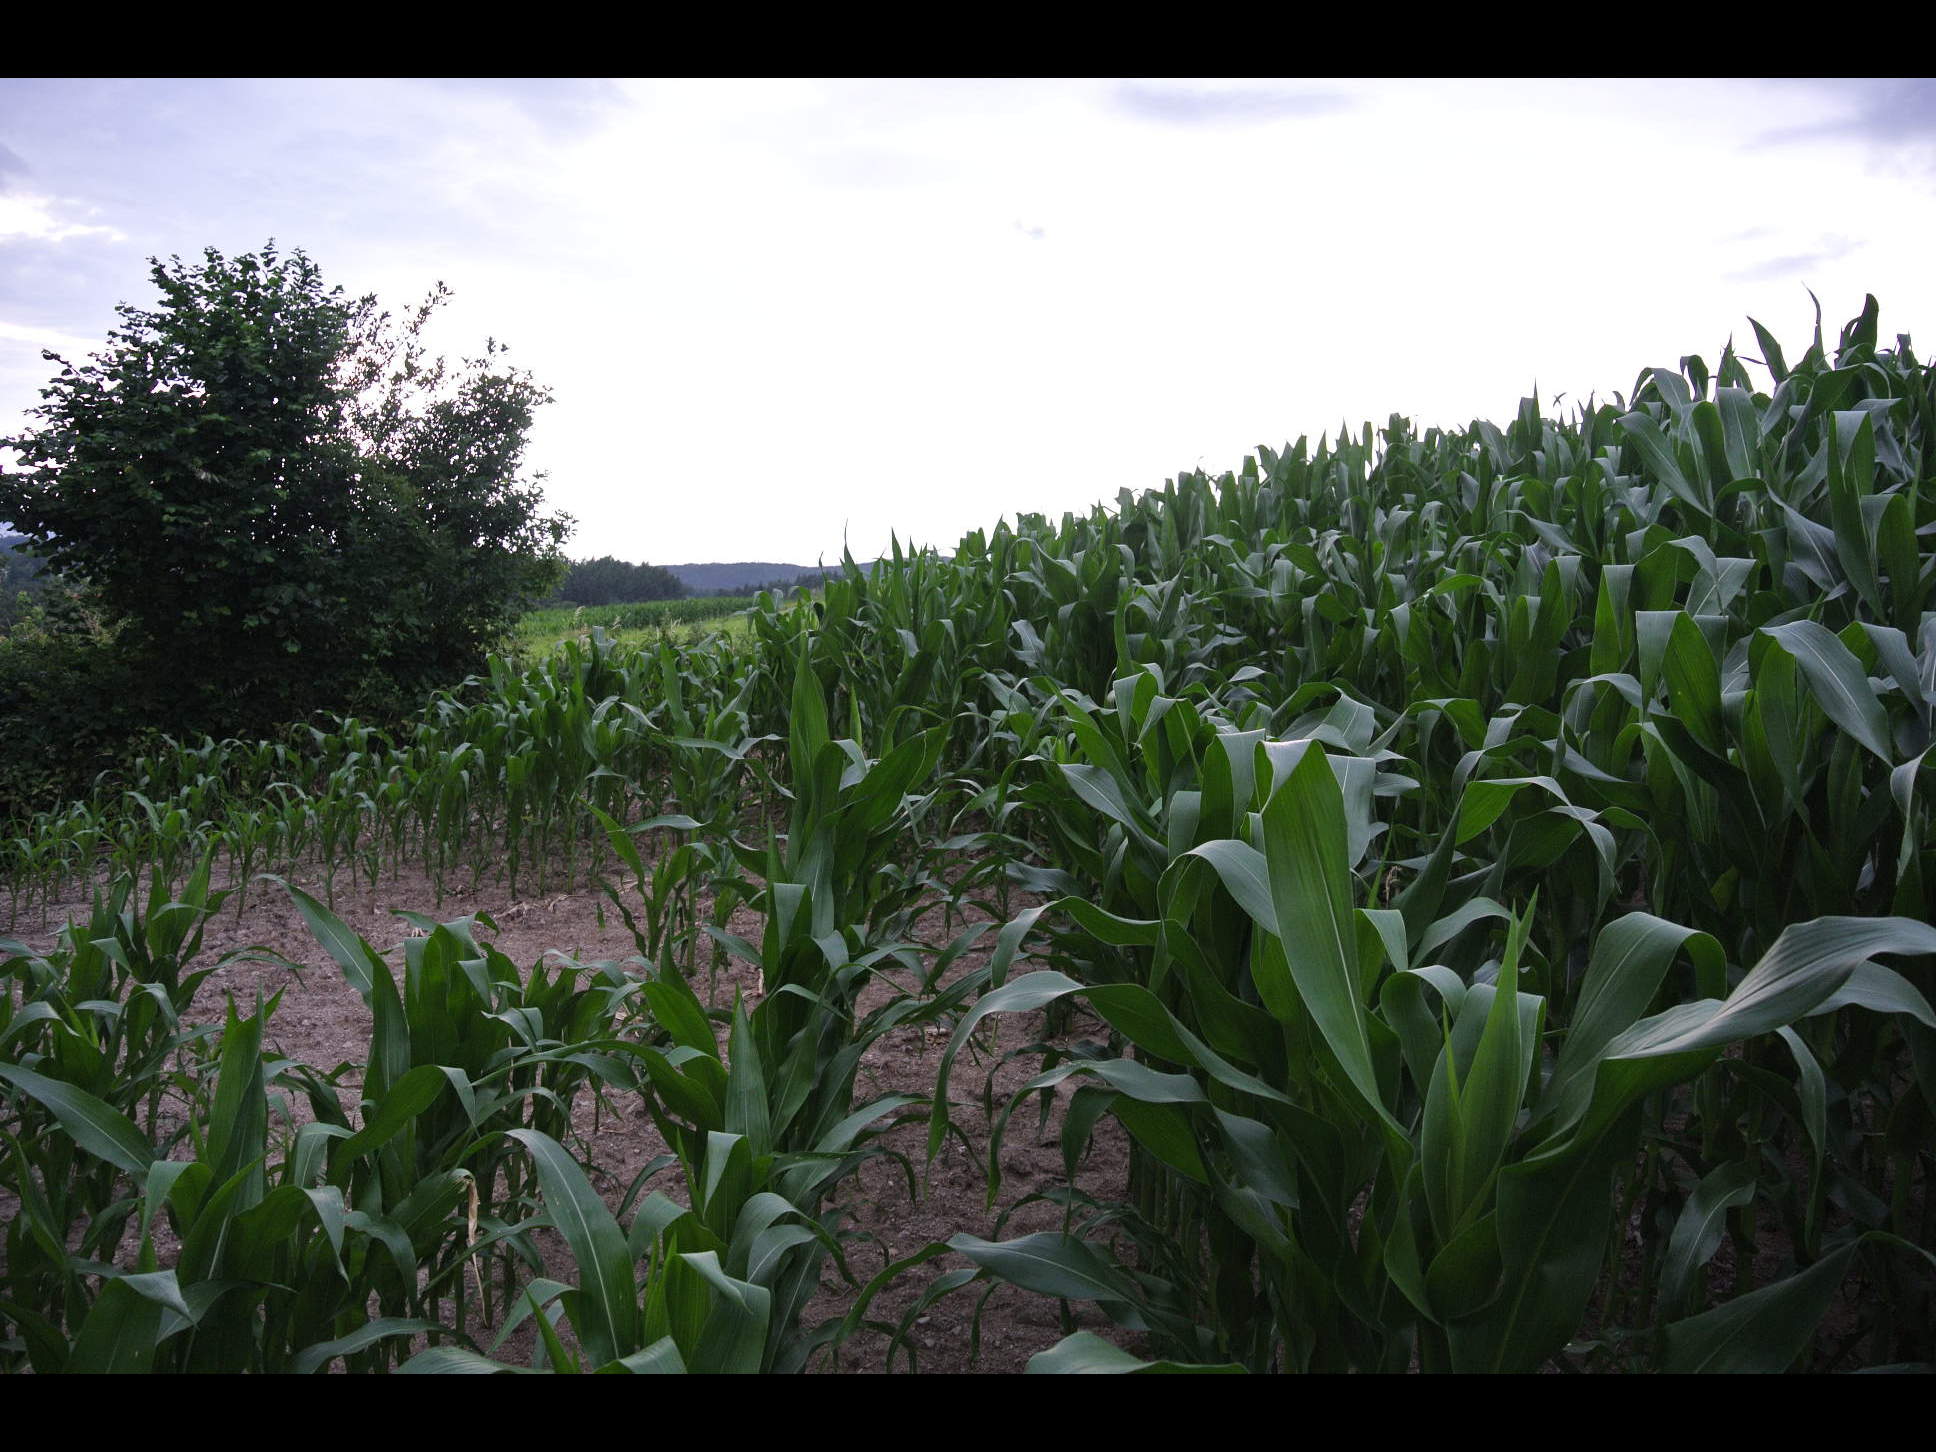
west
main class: Cropland
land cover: Maize
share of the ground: > 75 %
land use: Agriculture (excluding fallow land and kitchen gardens)
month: July
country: AT
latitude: 47.6702
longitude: 16.1962
